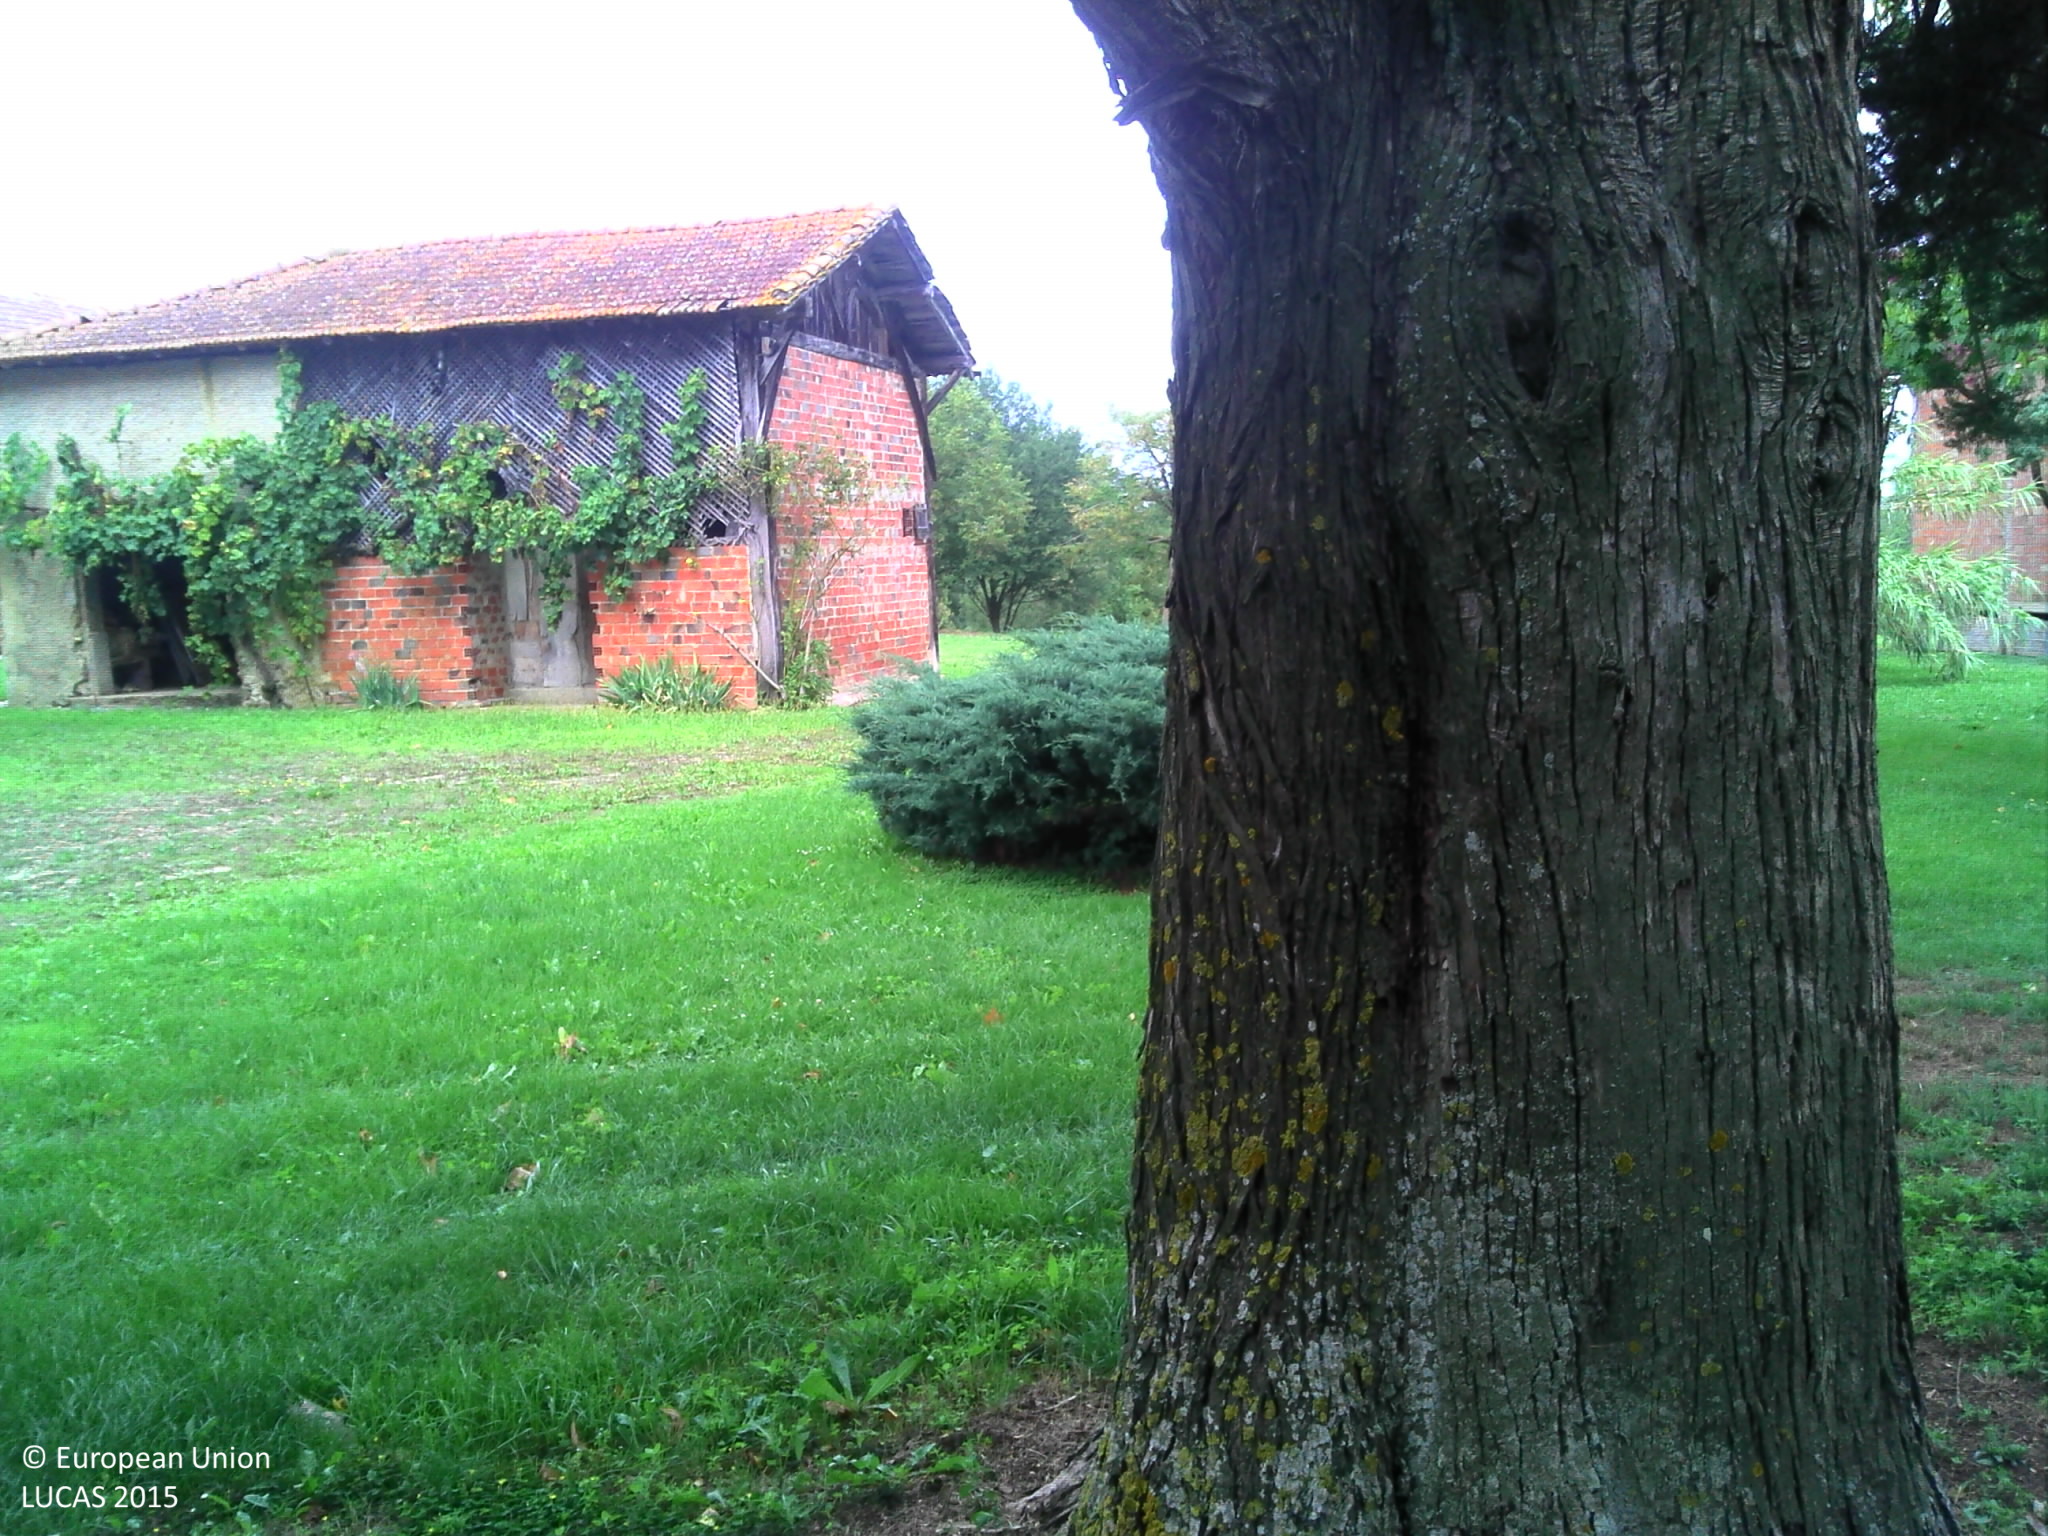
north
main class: Woodland
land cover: Pine dominated mixed woodland
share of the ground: > 75 %
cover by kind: coniferous forest trees 50 %, broadleaved forest trees 25 %, herbaceous plants 25 %
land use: Residential
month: August
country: FR
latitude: 43.4081
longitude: 0.7261
